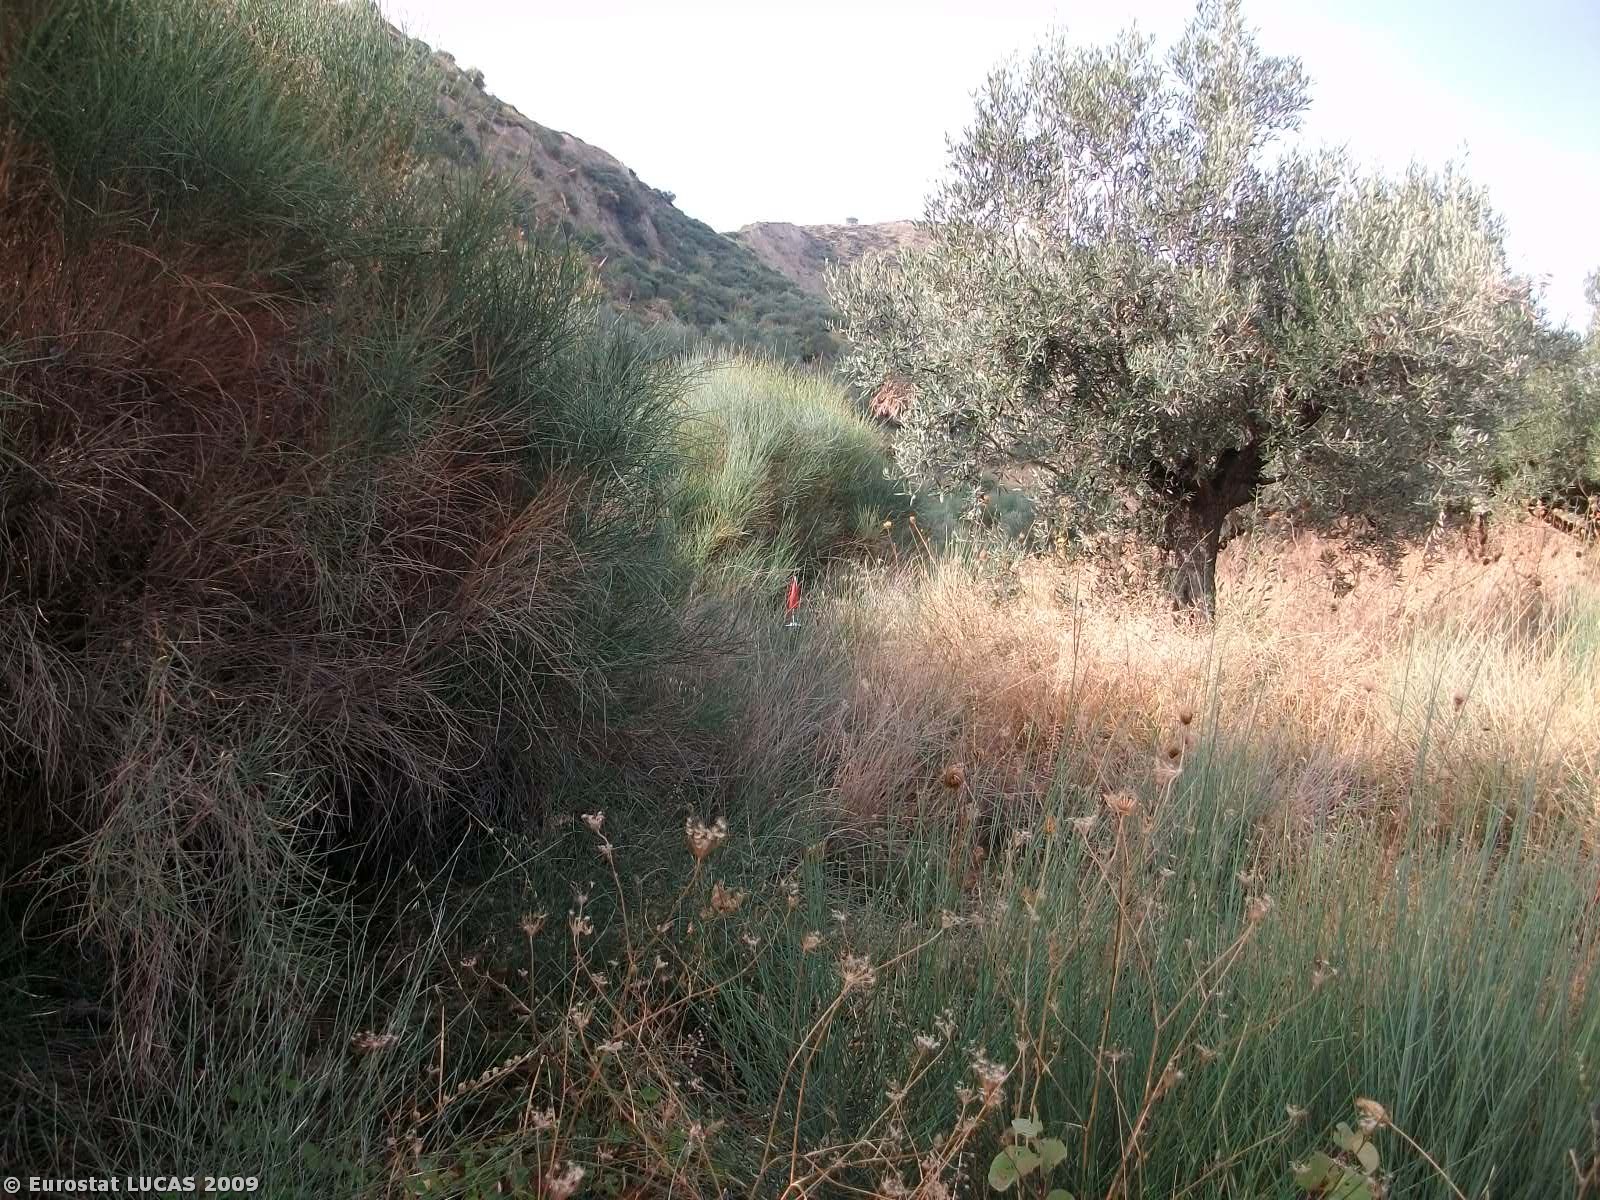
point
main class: Cropland
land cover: Olive groves
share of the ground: 10 - 25 %
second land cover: Grassland with sparse tree/shrub cover
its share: > 75 %
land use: Agriculture (excluding fallow land and kitchen gardens)
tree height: < 5 m
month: September
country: GR
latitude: 38.0649
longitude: 22.5657
